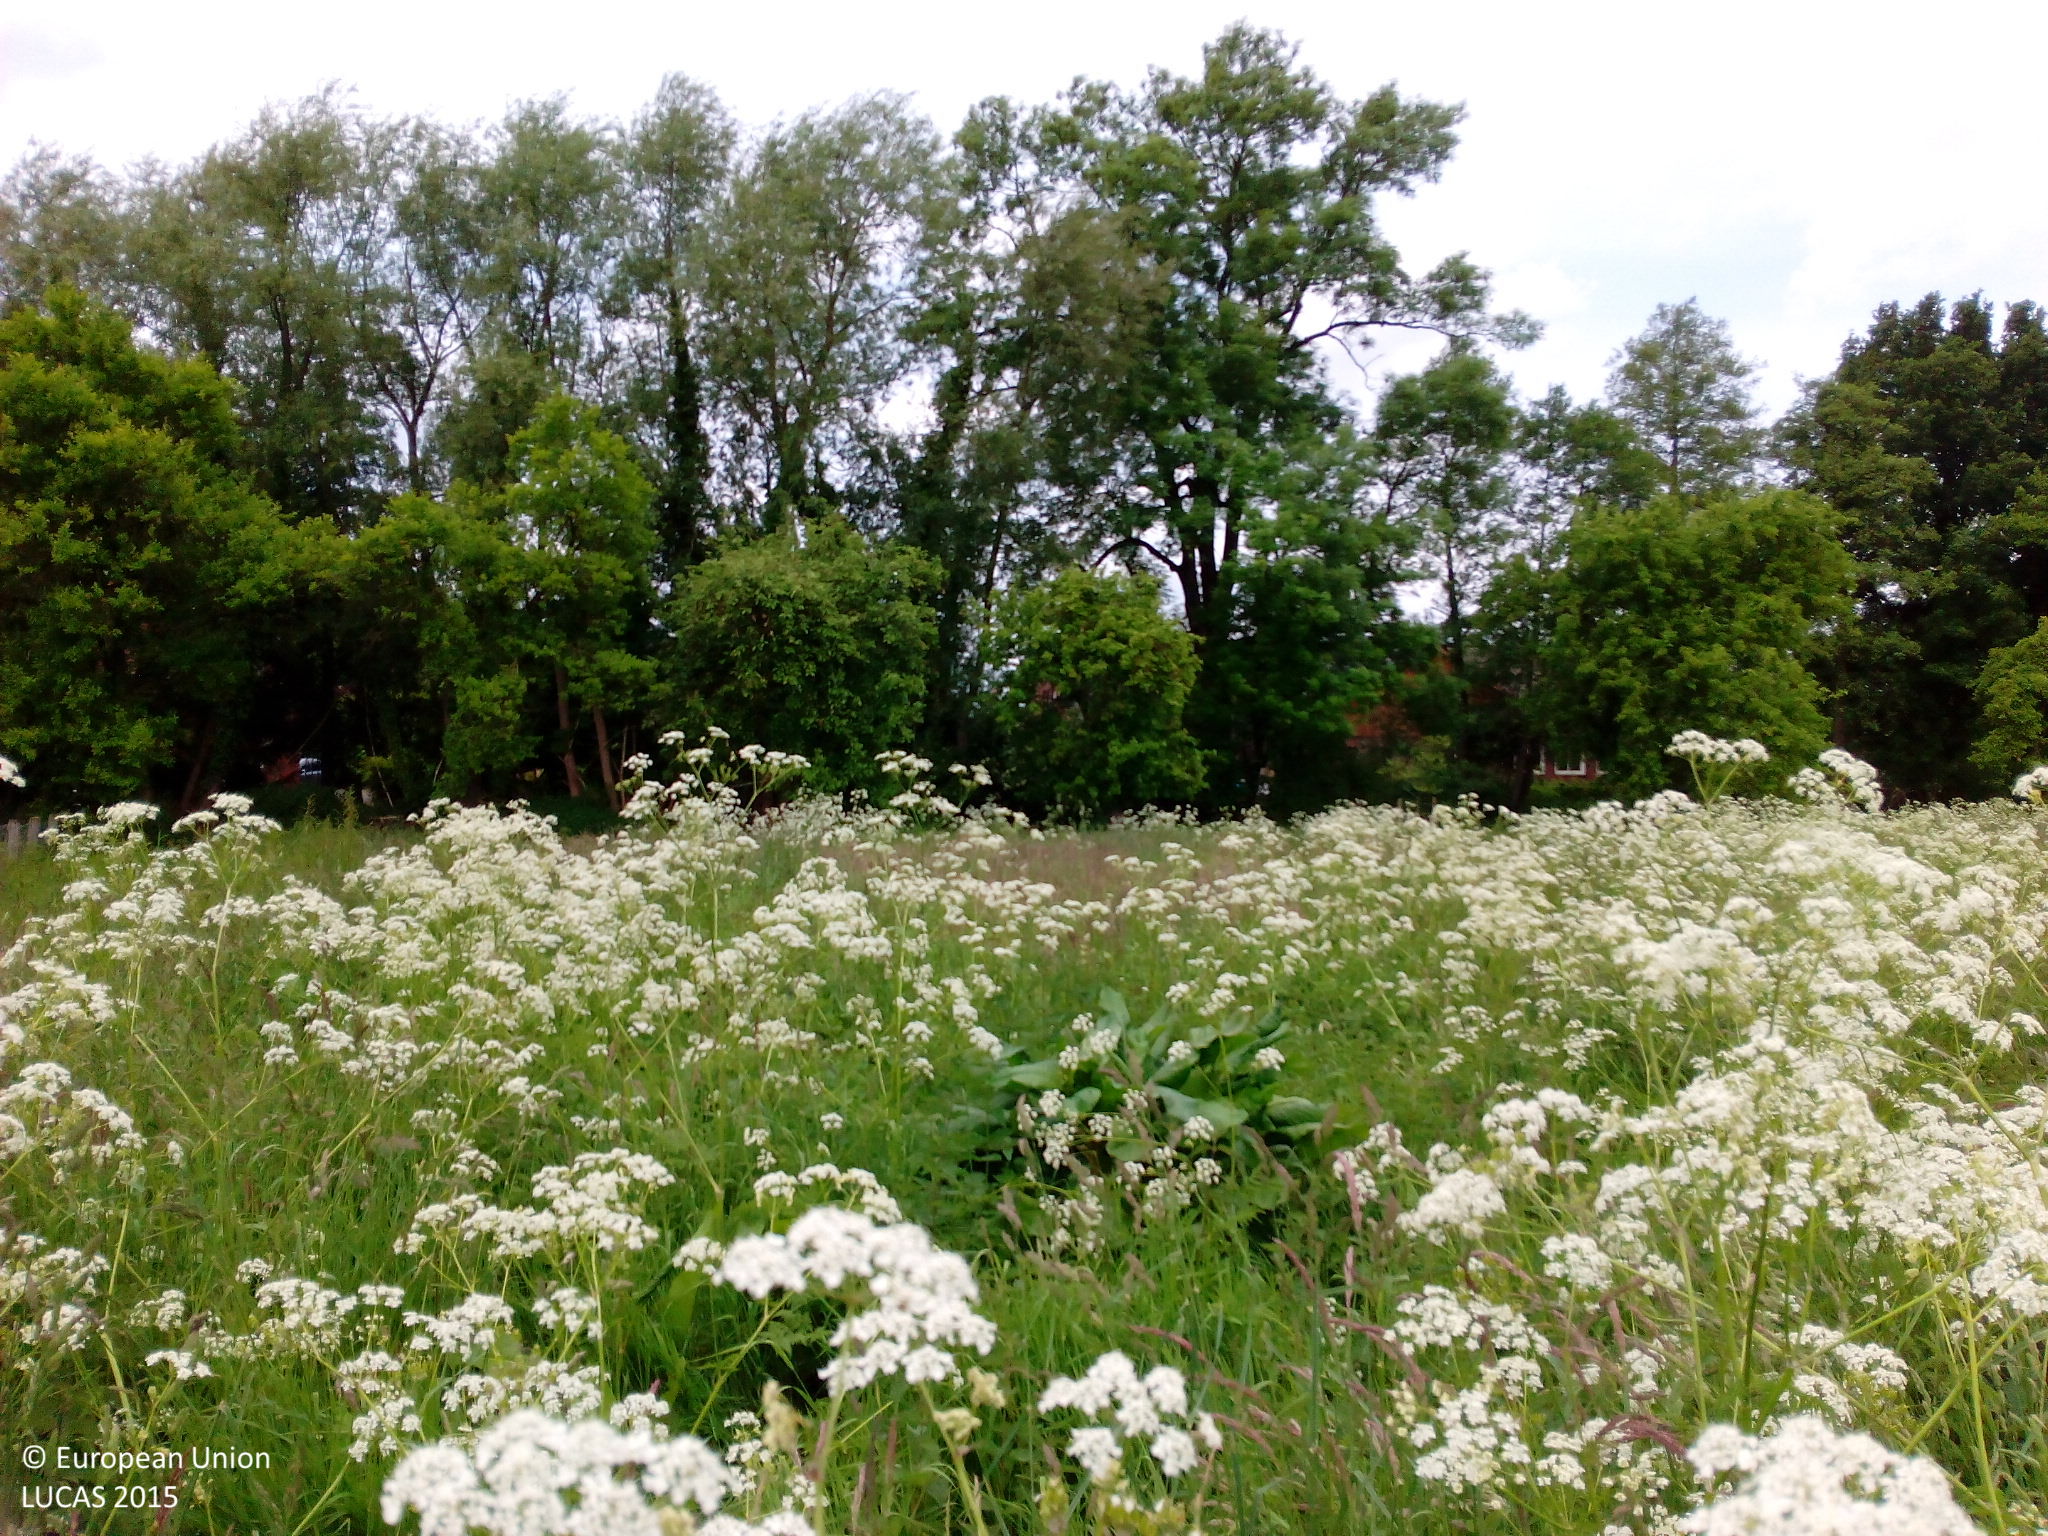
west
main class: Grassland
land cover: Grassland without tree/shrub cover
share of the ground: > 75 %
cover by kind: herbaceous plants 100 %
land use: Agriculture (excluding fallow land and kitchen gardens)
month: June
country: DE
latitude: 52.3125
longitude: 7.3747
